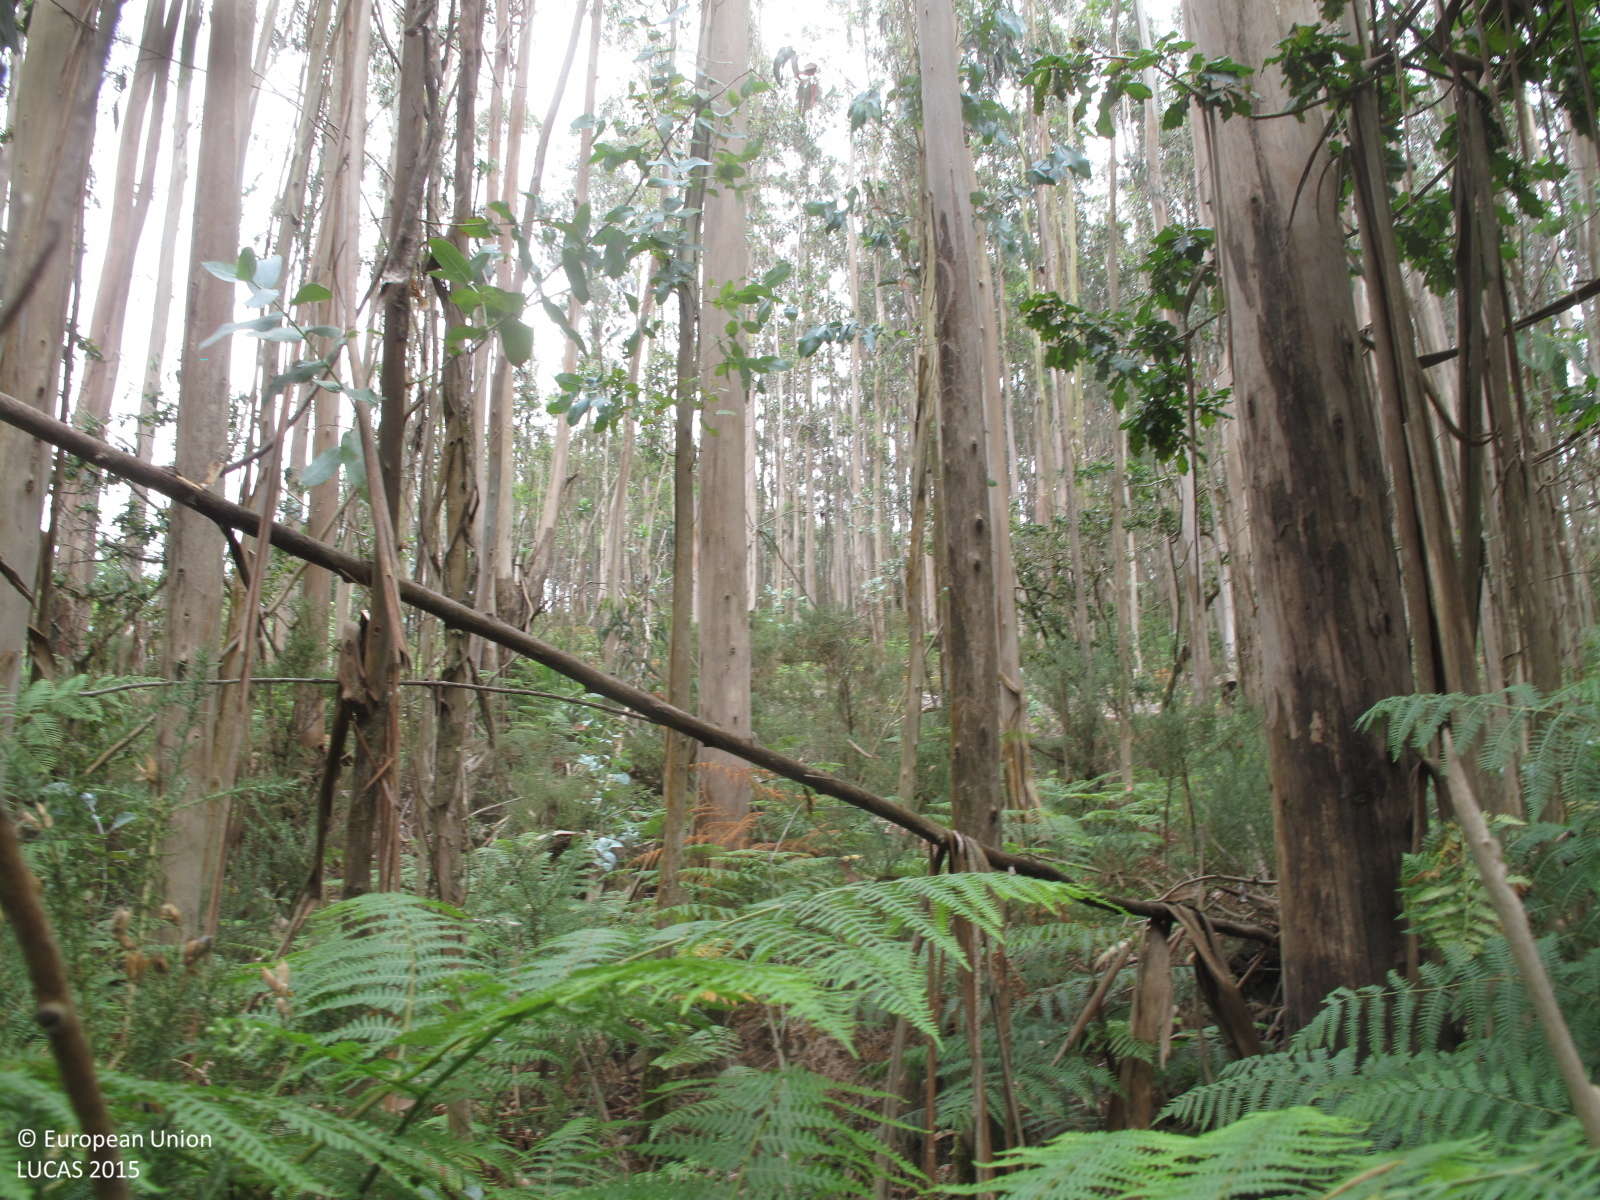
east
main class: Woodland
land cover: Broadleaved woodland
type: exotic forest
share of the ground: 50 - 75 %
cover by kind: broadleaved forest trees 60 %, herbaceous plants 20 %, shrubs 10 %, unconsolidated bare surface 10 %
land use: Forestry
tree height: > 5 m
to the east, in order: Broadleaved woodland
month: July
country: ES
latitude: 42.9419
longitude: -9.2087
